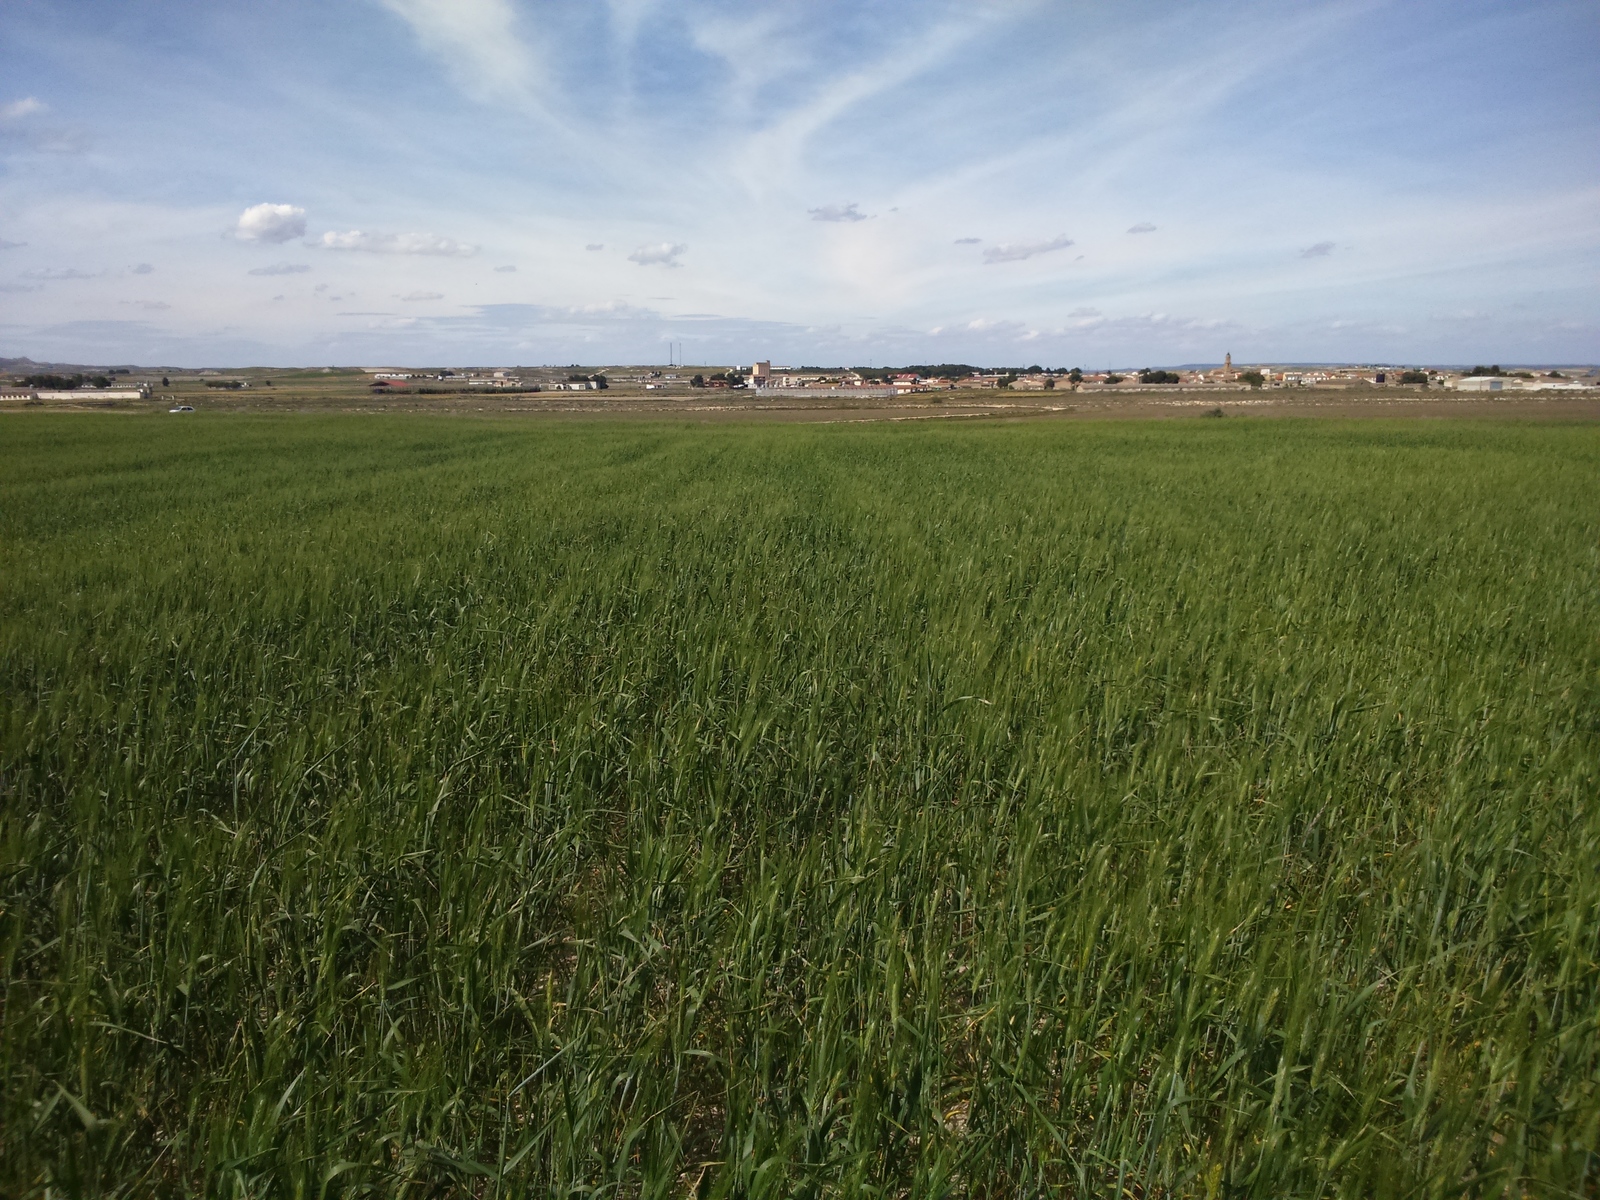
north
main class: Cropland
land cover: Barley
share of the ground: > 75 %
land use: Agriculture (excluding fallow land and kitchen gardens)
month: April
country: ES
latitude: 41.4869
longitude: -0.1600
